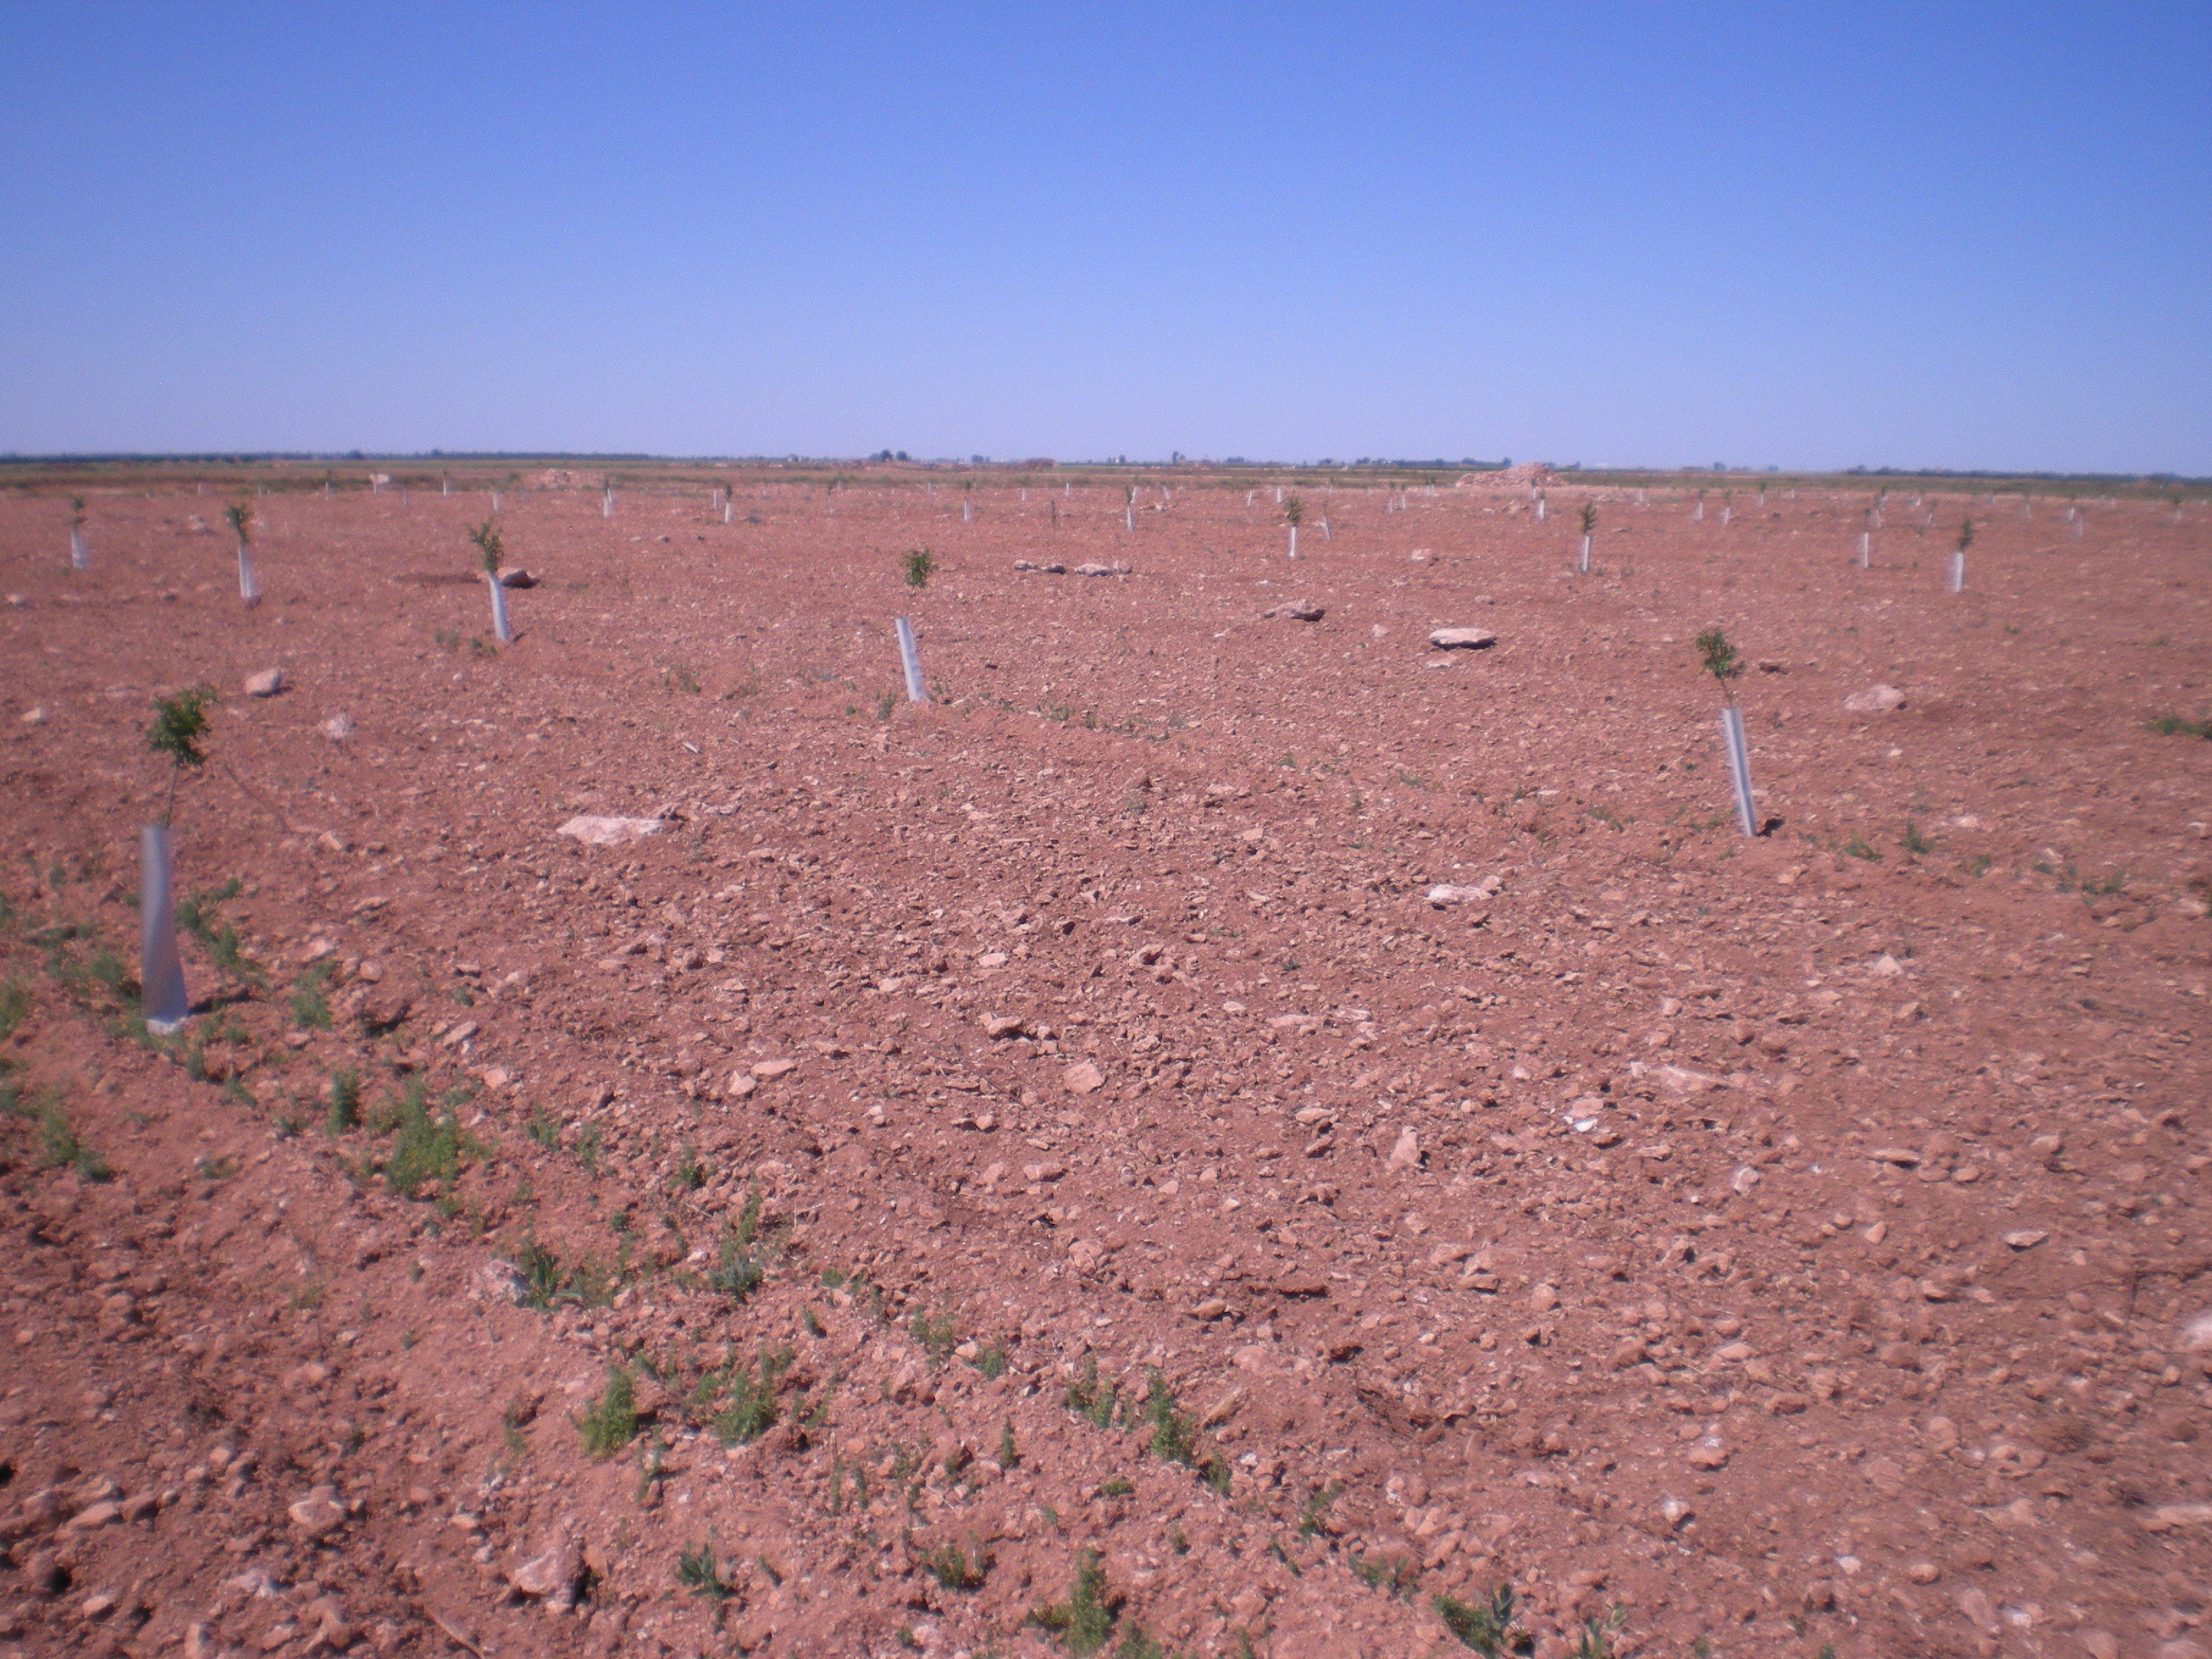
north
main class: Cropland
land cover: Nuts trees
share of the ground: < 10 %
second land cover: Other bare soil
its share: > 75 %
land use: Agriculture (excluding fallow land and kitchen gardens)
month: May
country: ES
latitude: 39.0956
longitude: -3.2063
